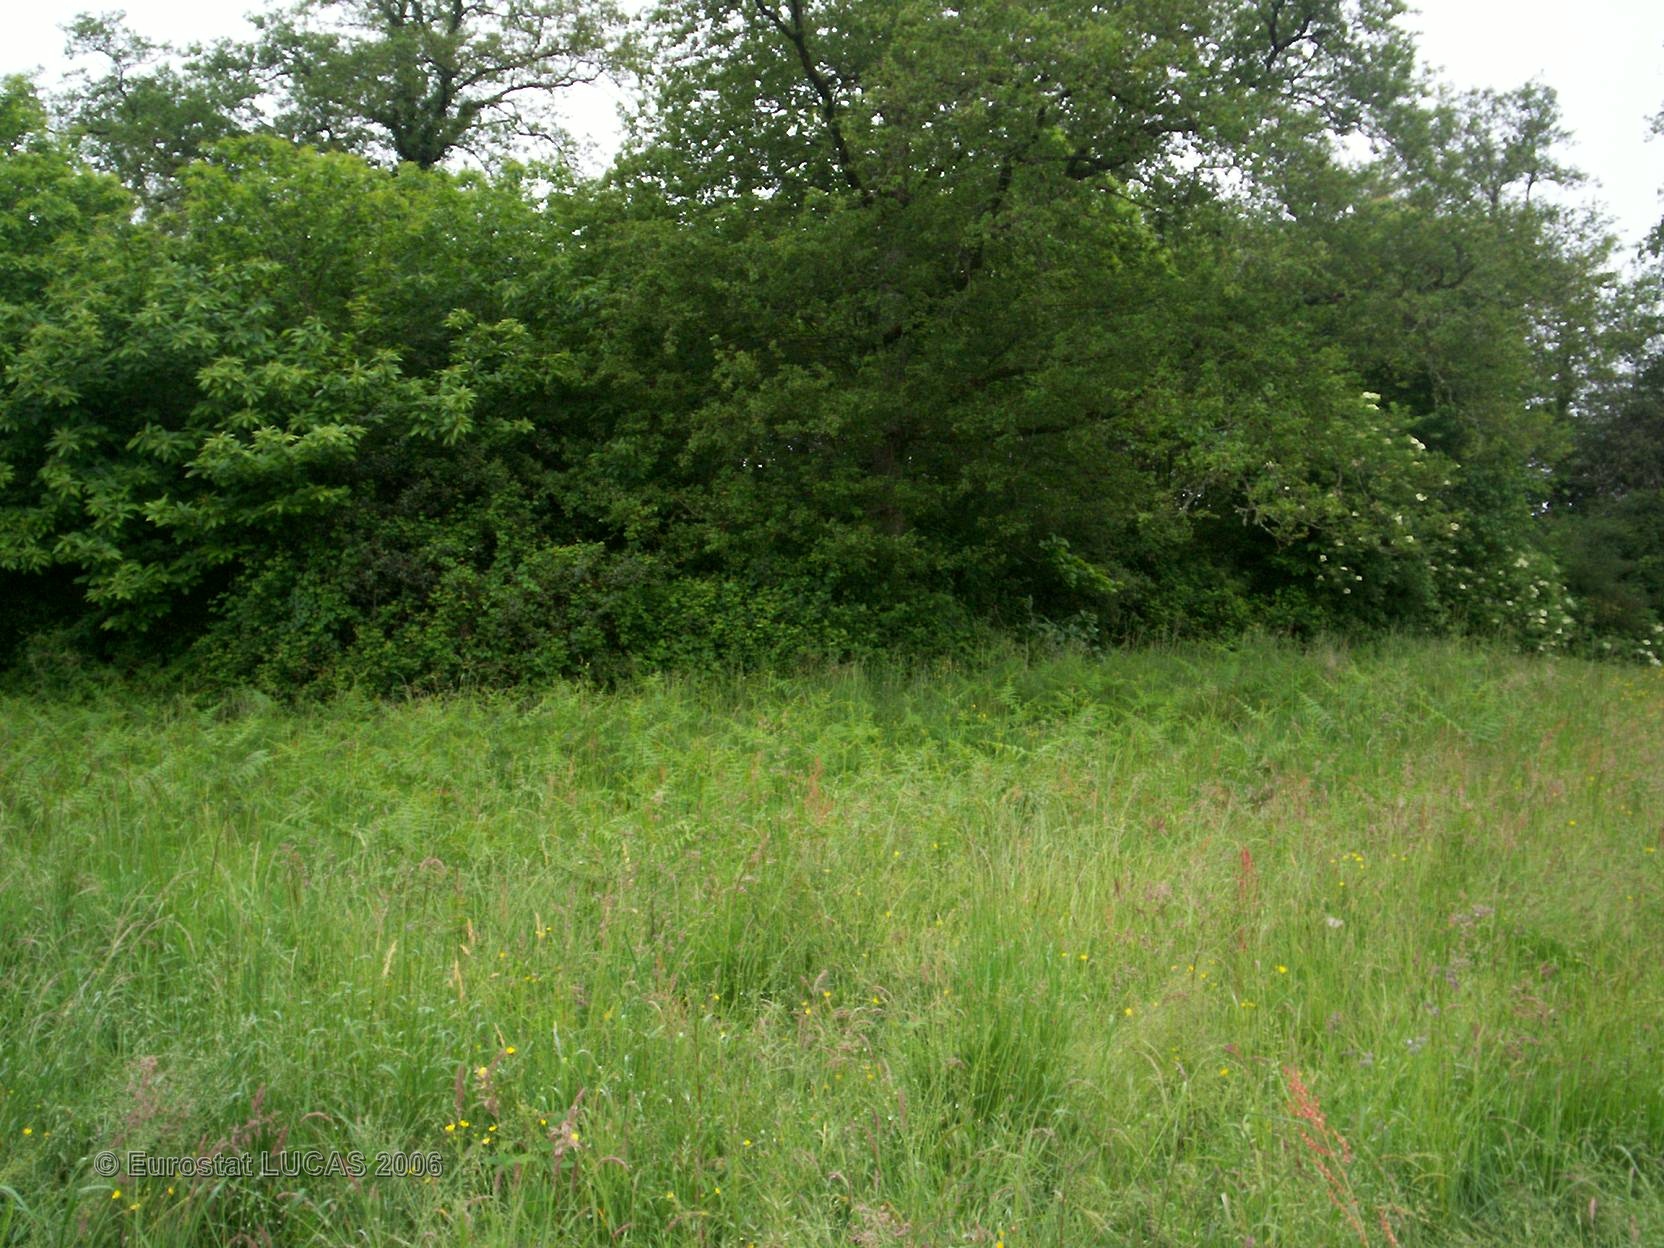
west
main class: Grassland
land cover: Grassland without tree/shrub cover
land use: Agriculture (excluding fallow land and kitchen gardens)
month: May
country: FR
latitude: 45.8213
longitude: 0.7330
